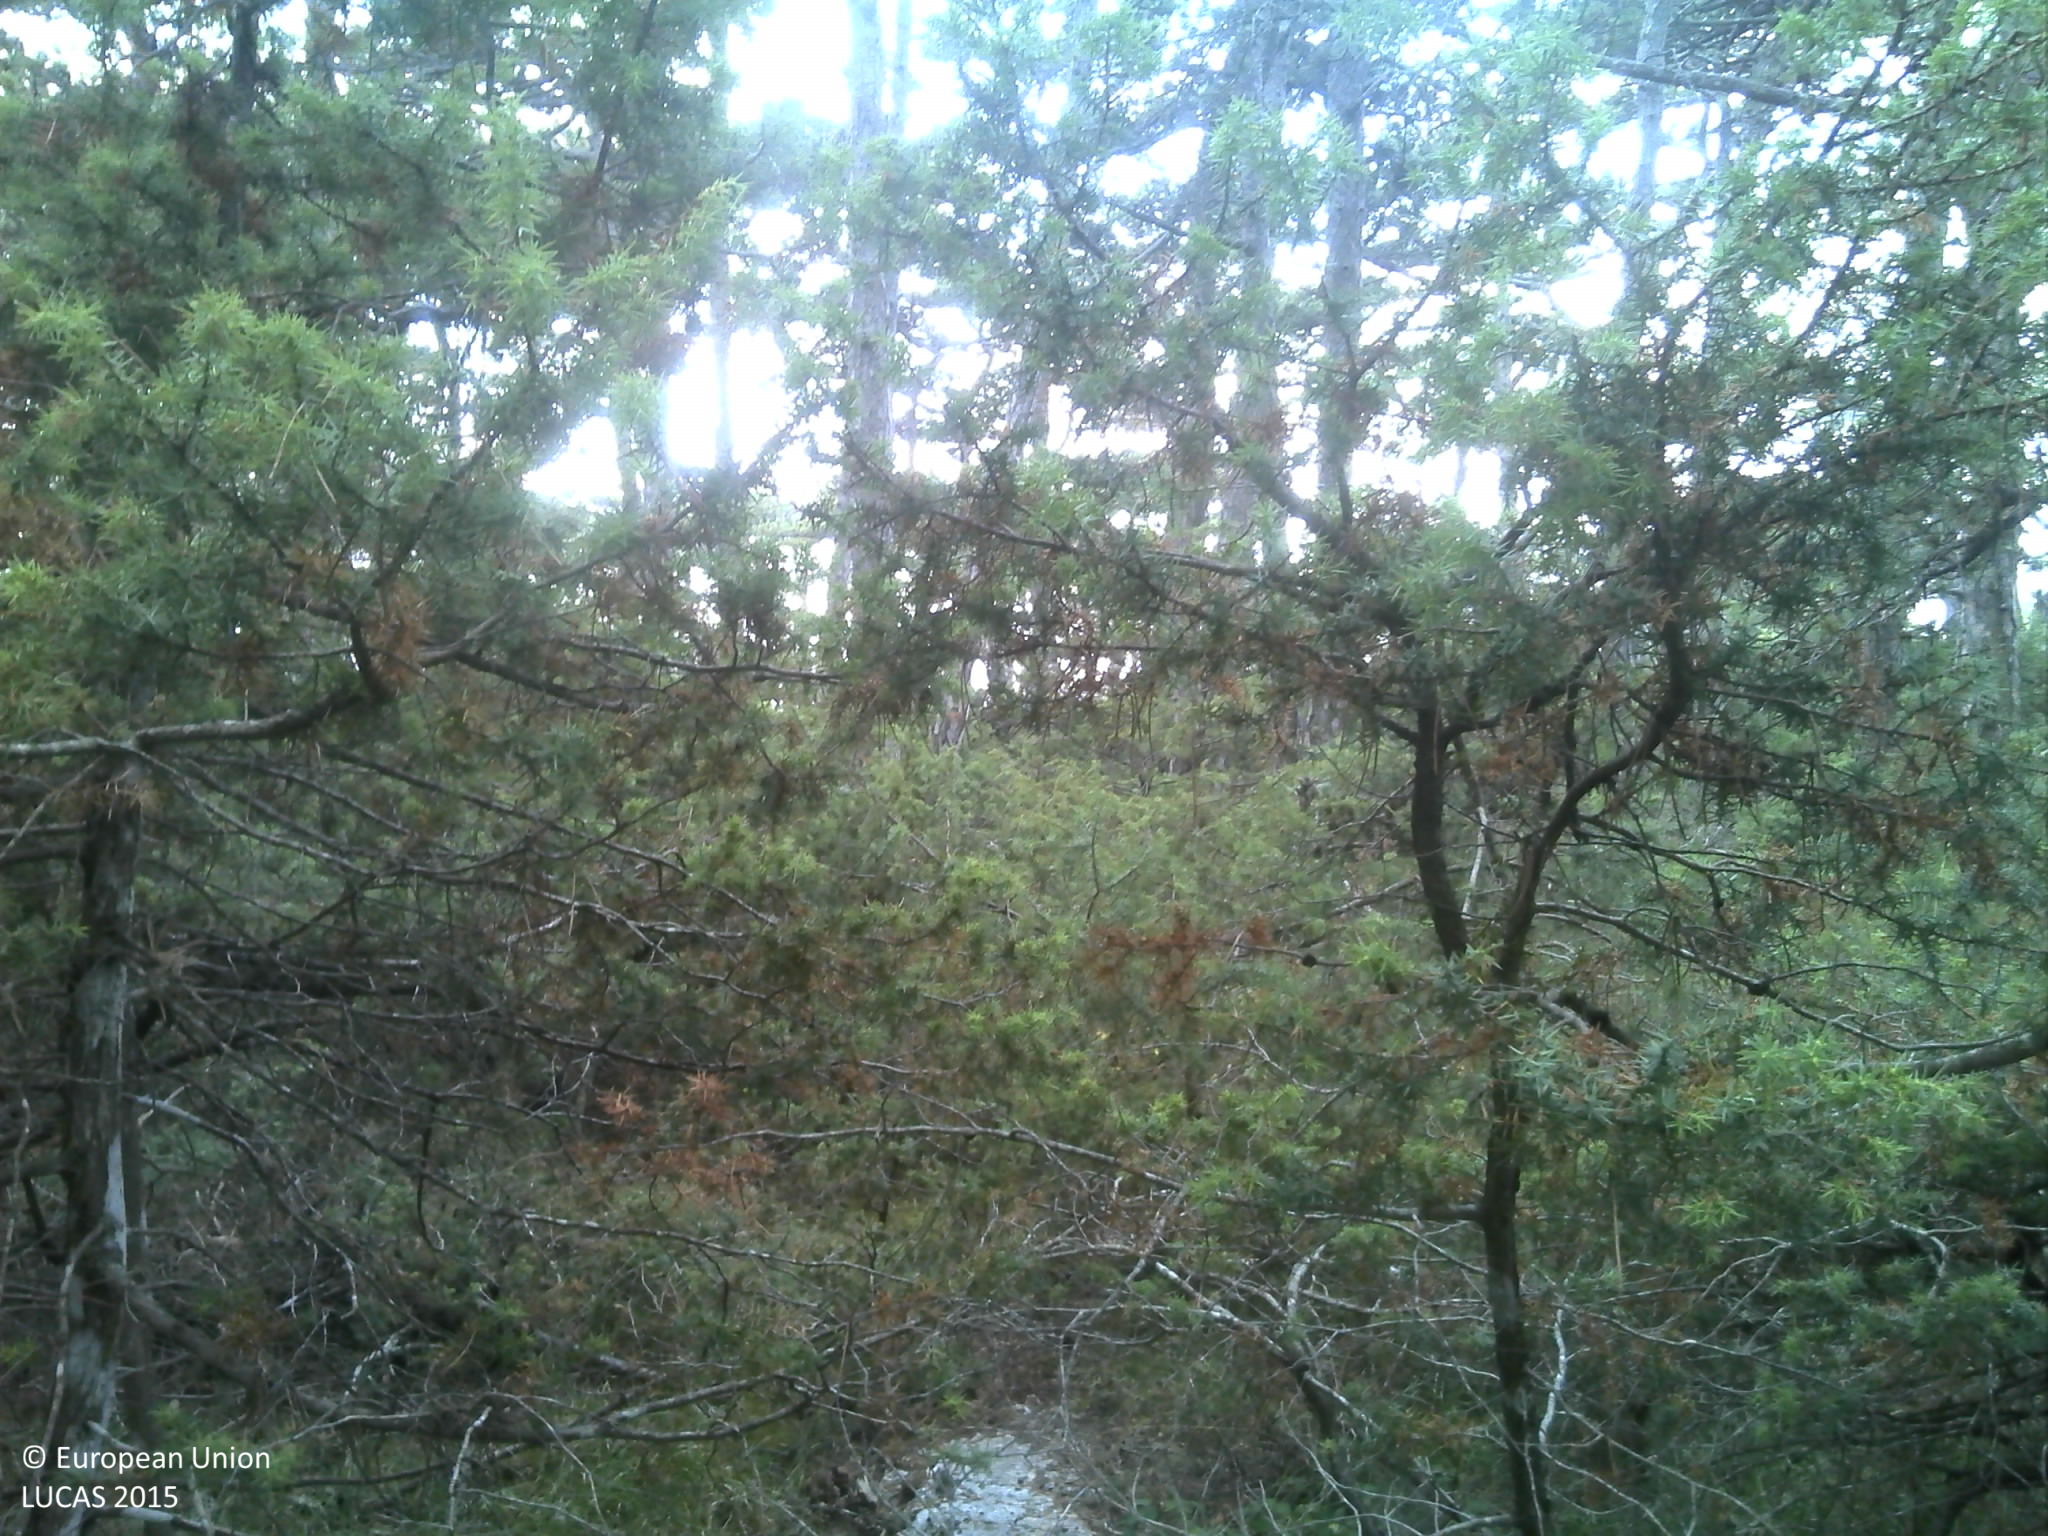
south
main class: Woodland
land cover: Pine dominated coniferous woodland
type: coniferous forest of the mediterranean region
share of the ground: > 75 %
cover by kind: coniferous forest trees 75 %, shrubs 15 %, herbaceous plants 5 %, consolidated bare surface 5 %
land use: Semi-natural and natural areas not in use
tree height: > 5 m
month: July
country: HR
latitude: 43.2908
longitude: 16.5839
